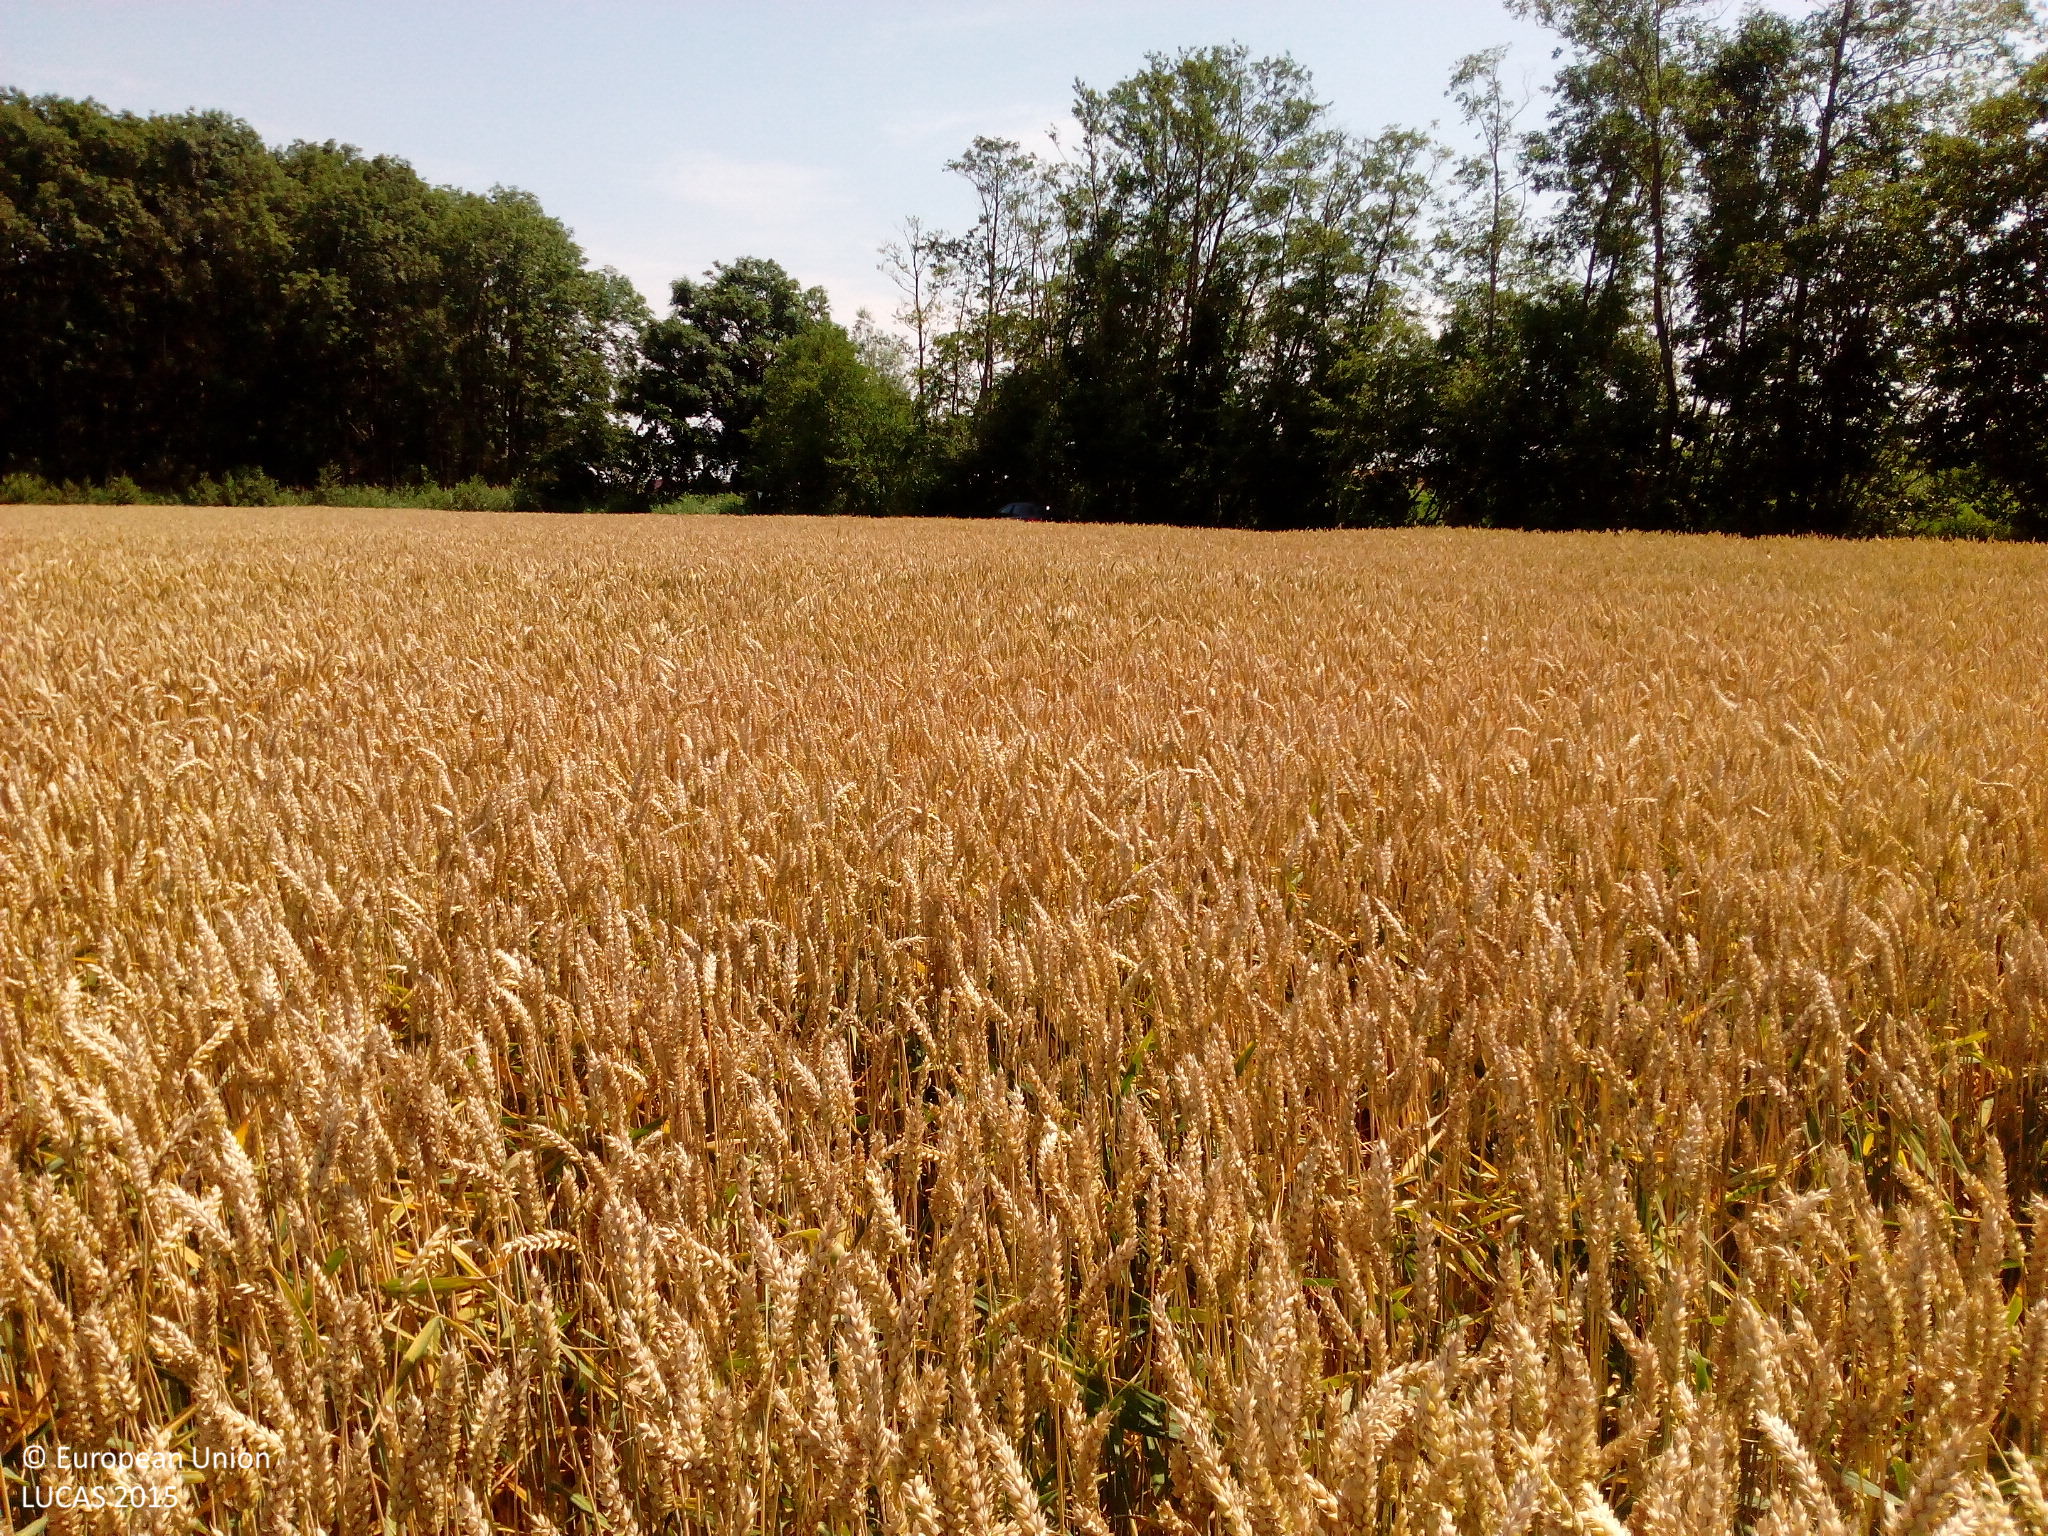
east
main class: Cropland
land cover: Common wheat
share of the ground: > 75 %
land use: Agriculture (excluding fallow land and kitchen gardens)
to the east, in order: Common wheat; Paved roads, cycling and walking lanes; Lines of trees; Rivers and streams; Lines of trees; Inland marshes; Grassland without tree/shrub cover; Ditches and canals; Grassland without tree/shrub cover; Inland fresh water bodies
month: July
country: DE
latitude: 49.6267
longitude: 9.9585
